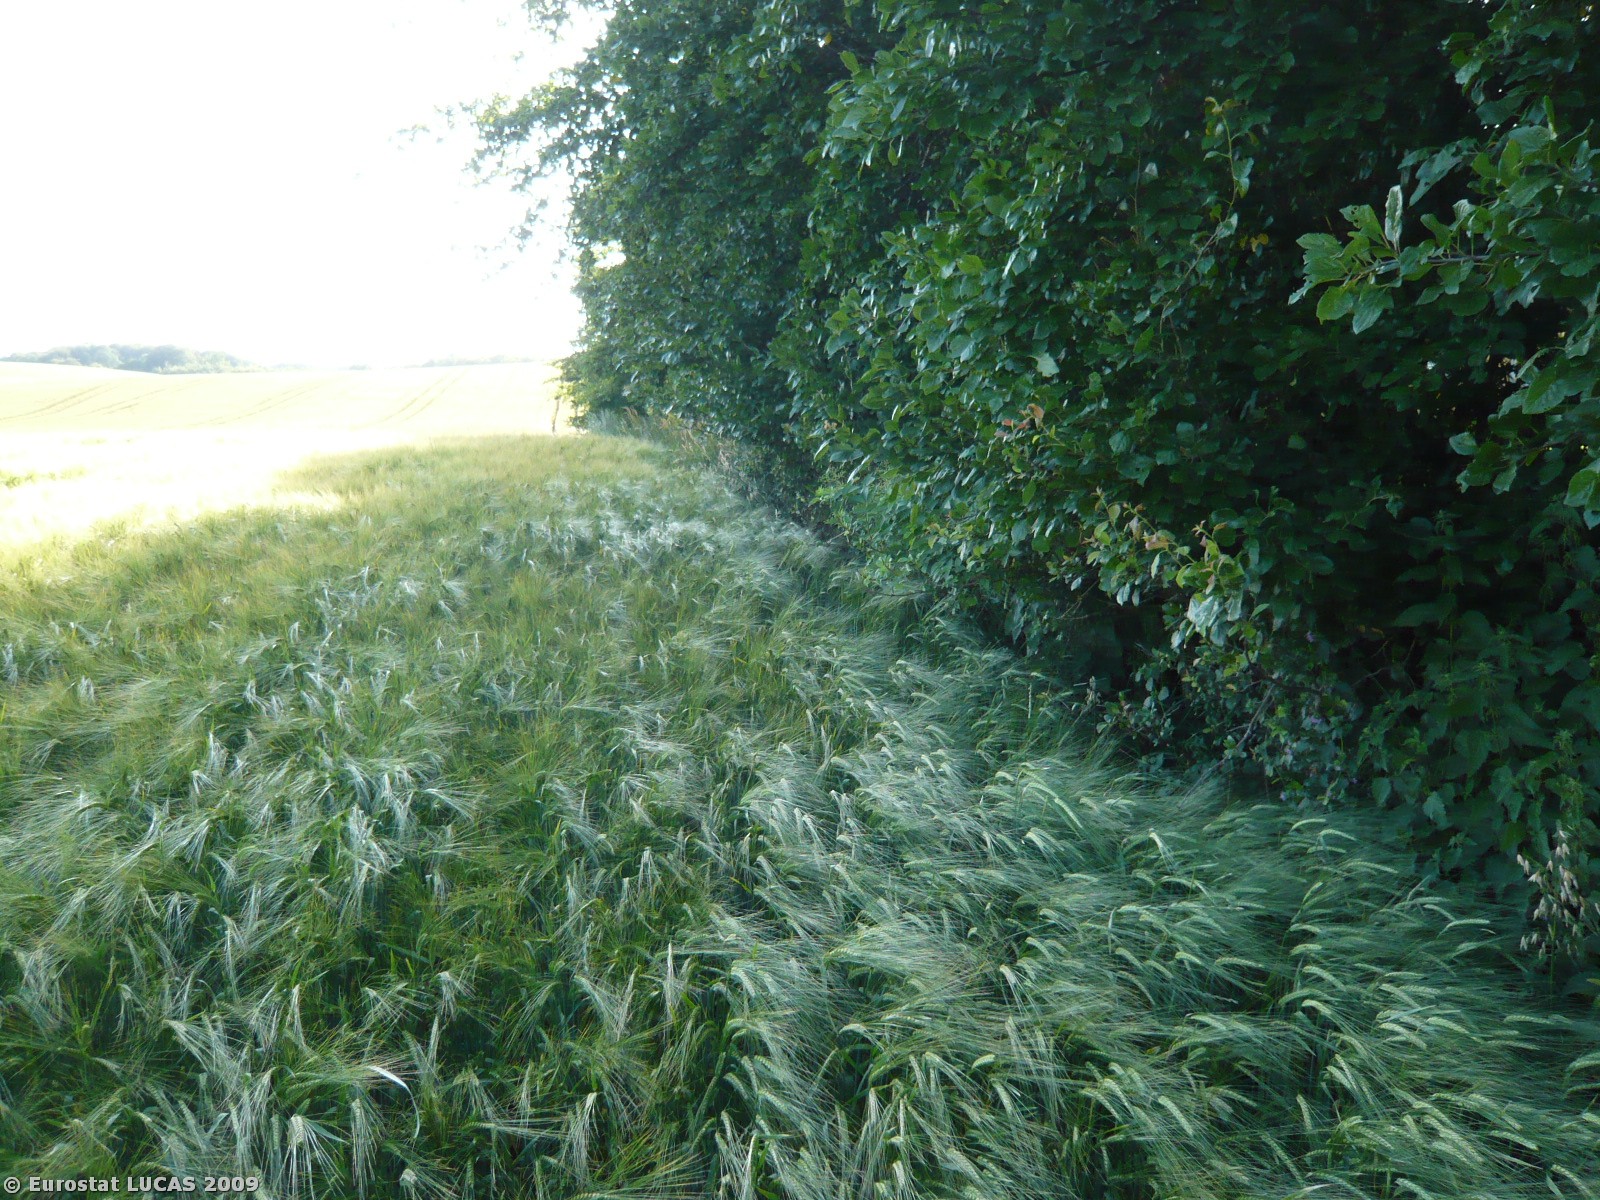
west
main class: Woodland
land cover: Broadleaved woodland
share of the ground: > 75 %
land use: Residential
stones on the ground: < 10 %
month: July
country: DK
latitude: 55.5691
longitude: 11.3784
